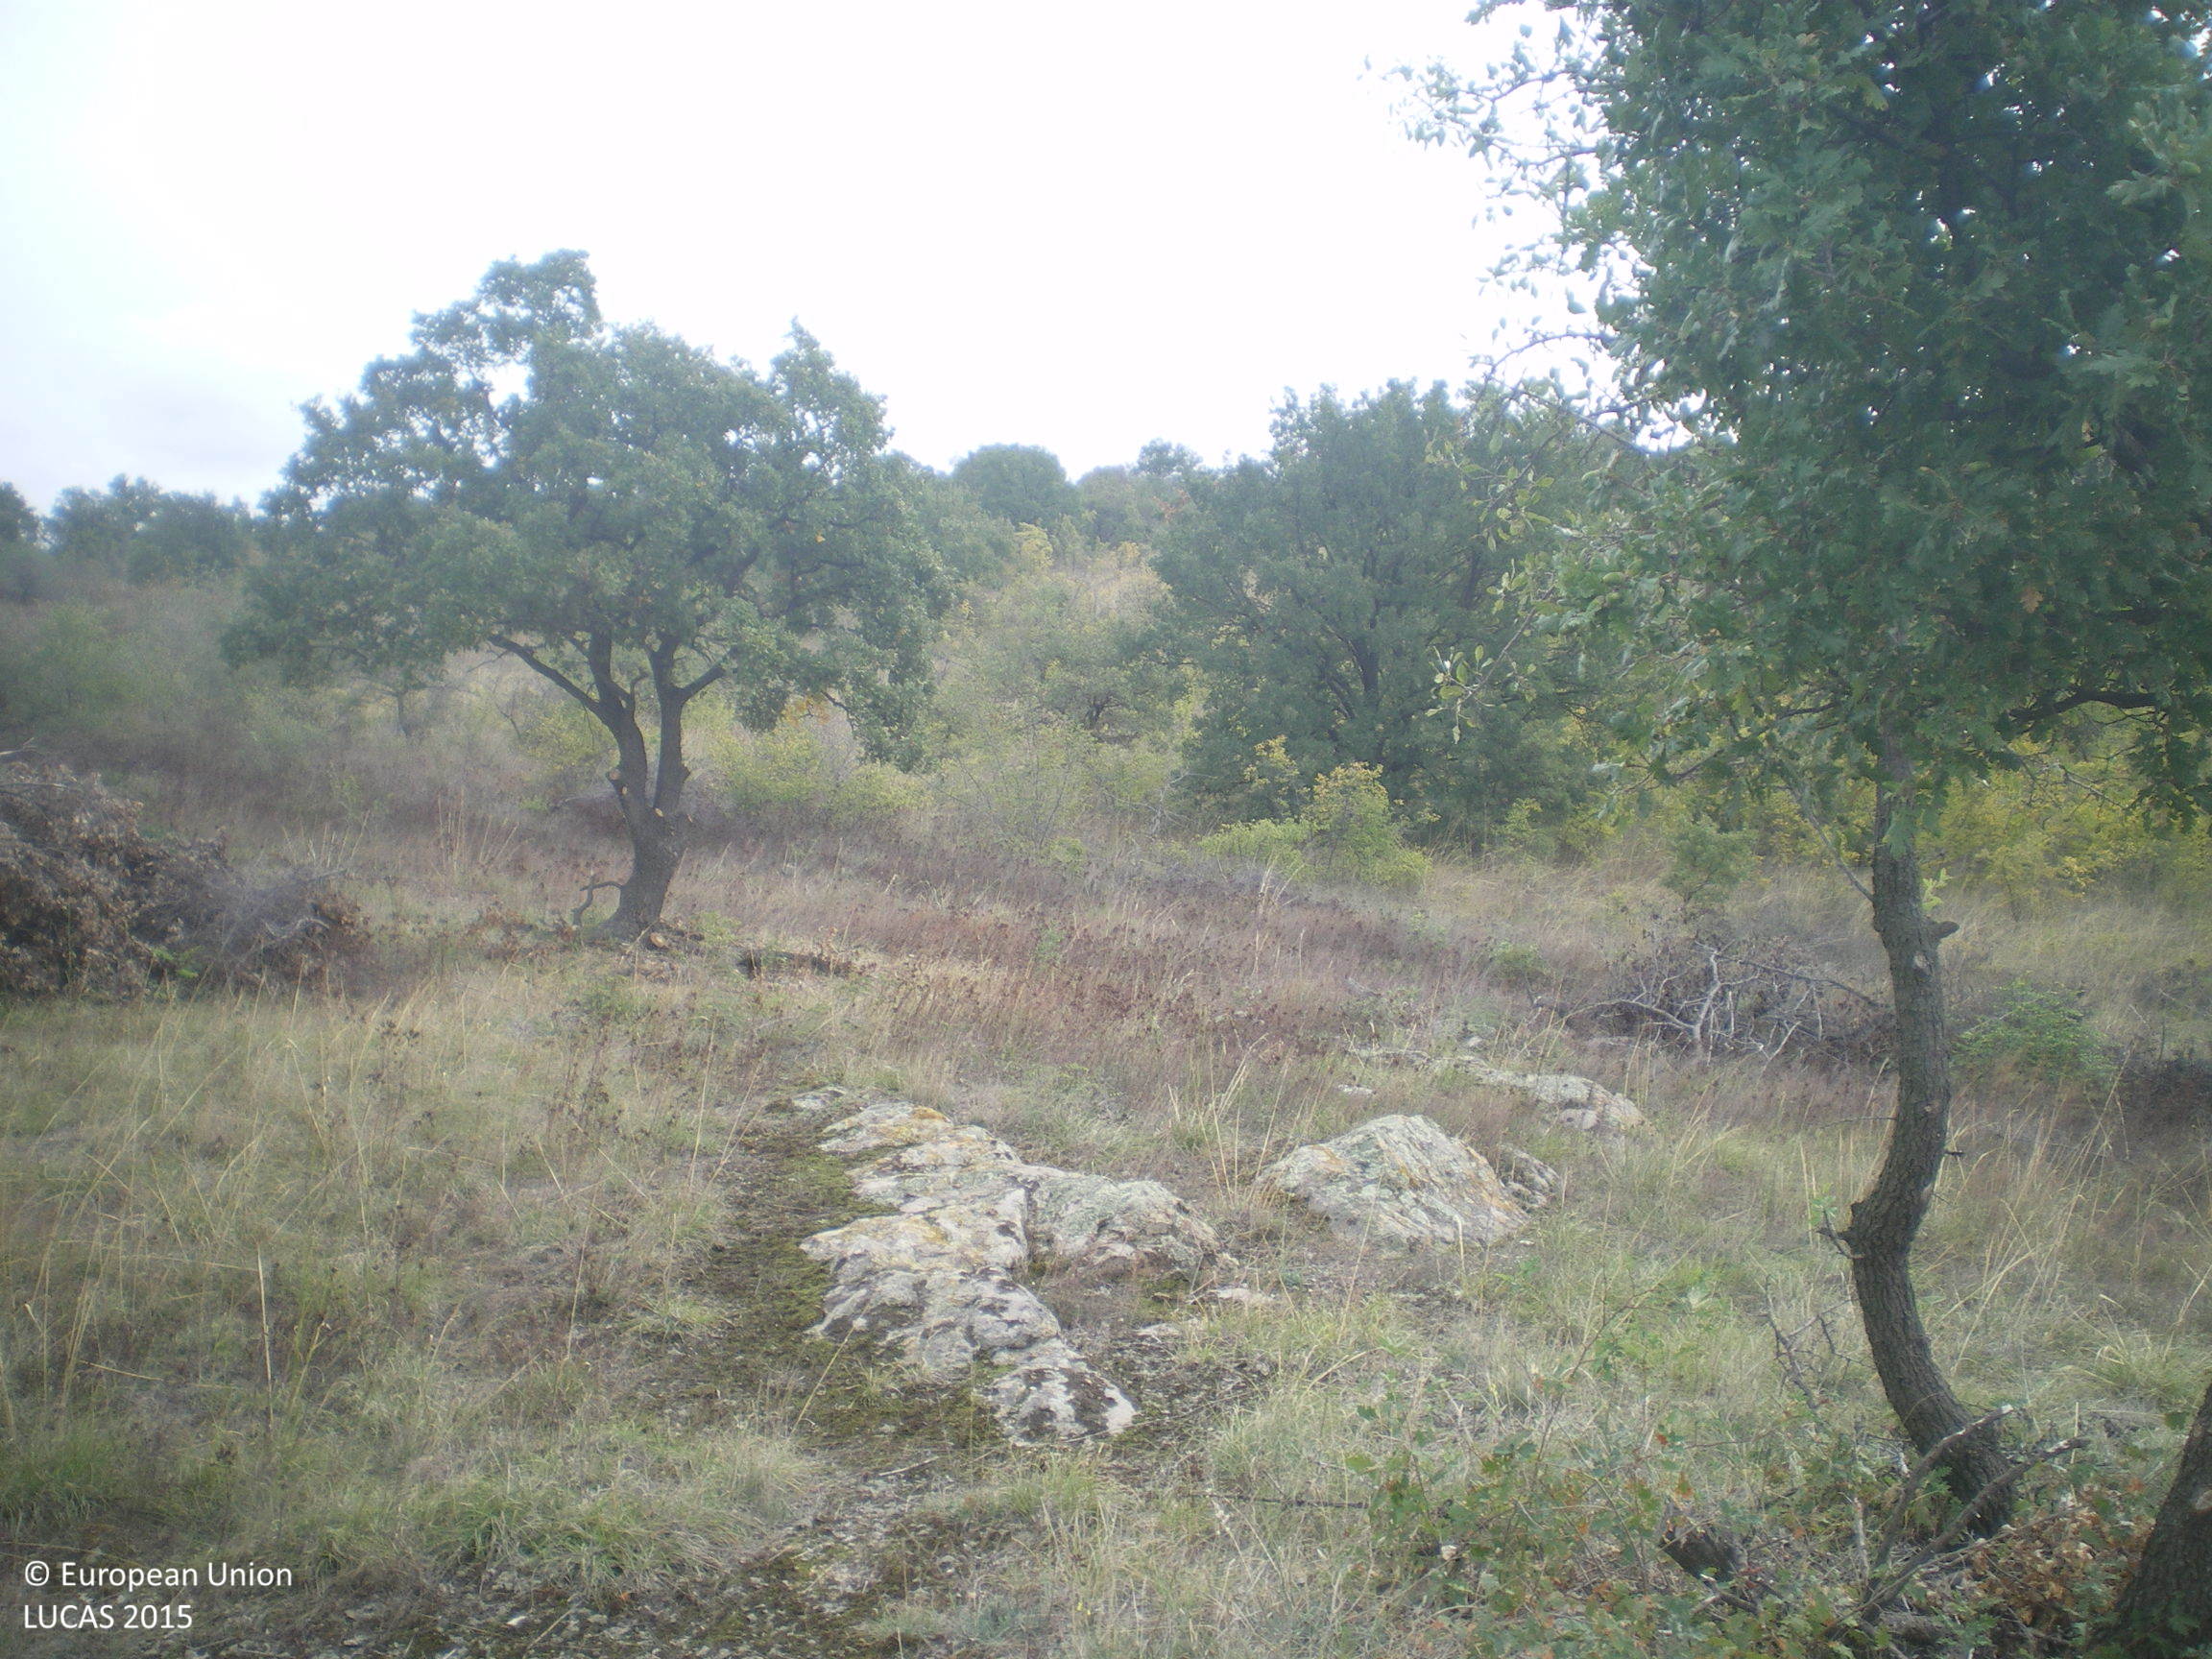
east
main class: Grassland
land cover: Grassland with sparse tree/shrub cover
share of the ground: > 75 %
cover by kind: herbaceous plants 85 %, shrubs 10 %, broadleaved forest trees 5 %
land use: Agriculture (excluding fallow land and kitchen gardens)
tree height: > 5 m
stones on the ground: < 10 %
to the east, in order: Grassland with sparse tree/shrub cover; Grassland without tree/shrub cover; Grassland with sparse tree/shrub cover
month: October
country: BG
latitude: 41.9723
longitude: 26.0404
